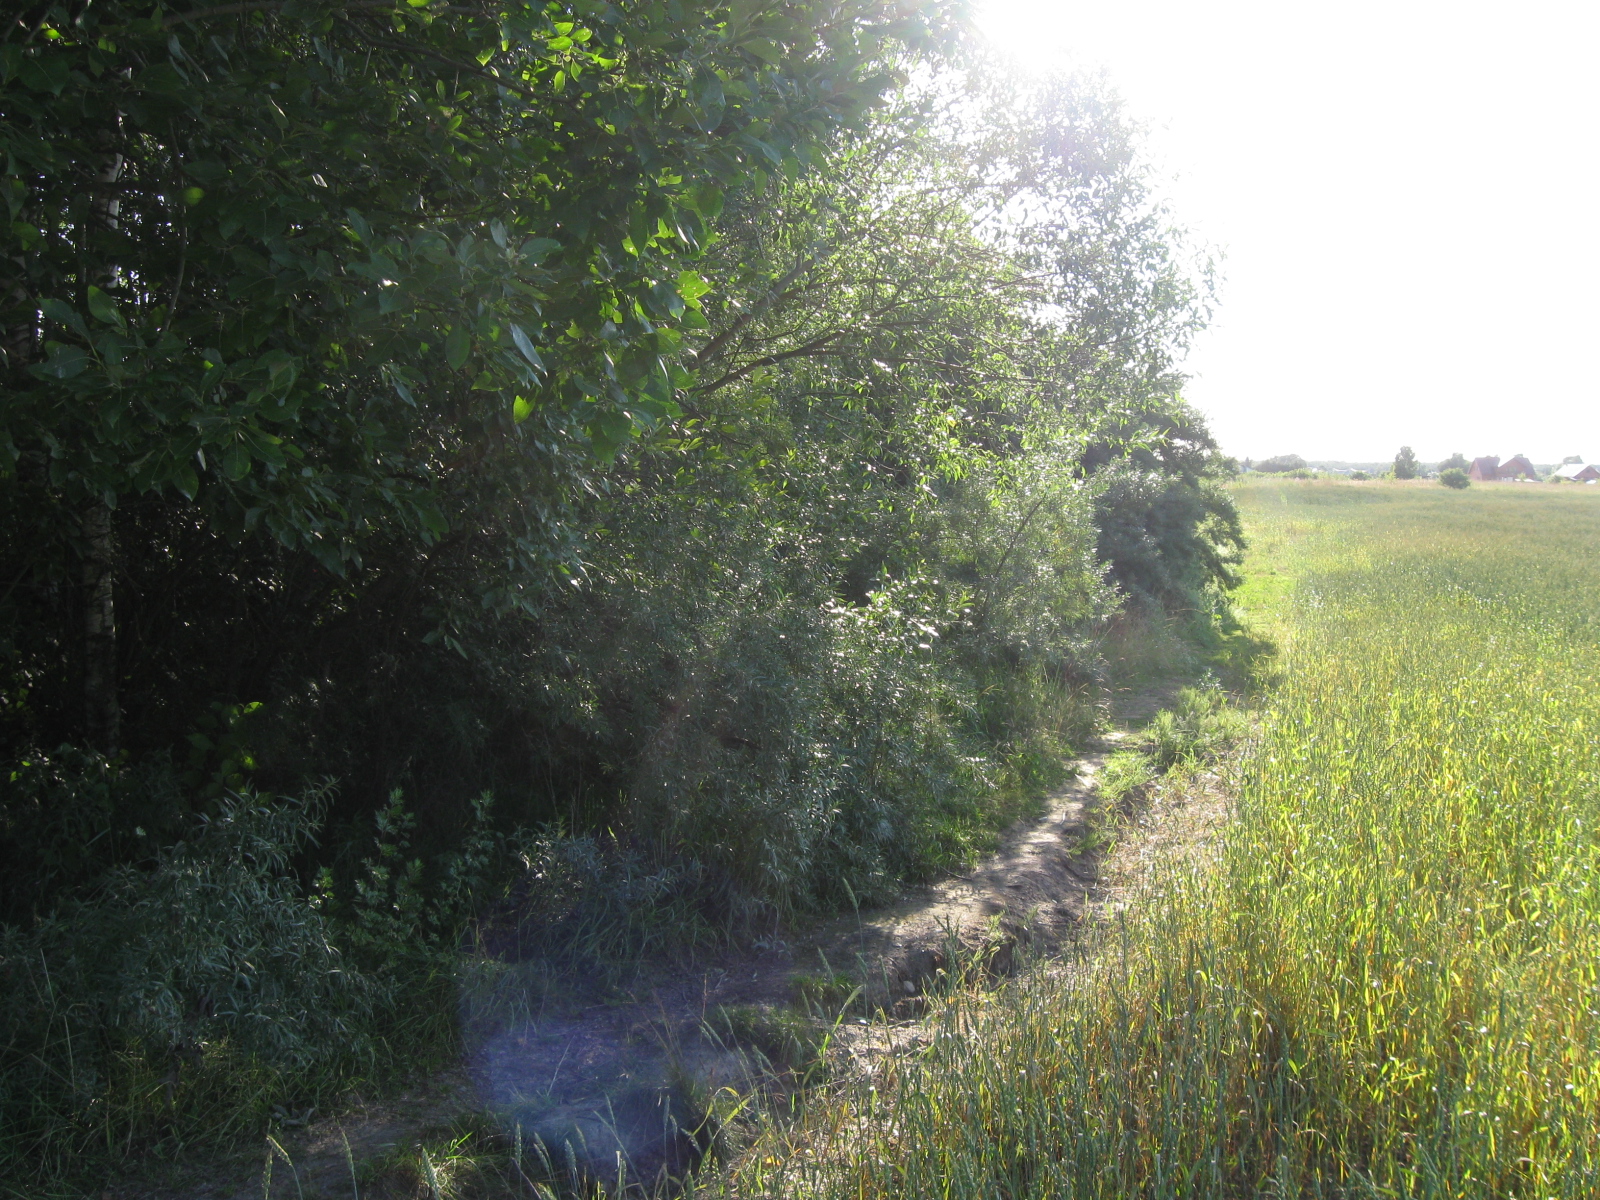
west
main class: Cropland
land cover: Common wheat
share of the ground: > 75 %
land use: Agriculture (excluding fallow land and kitchen gardens)
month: July
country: LT
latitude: 54.8726
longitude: 23.7846
